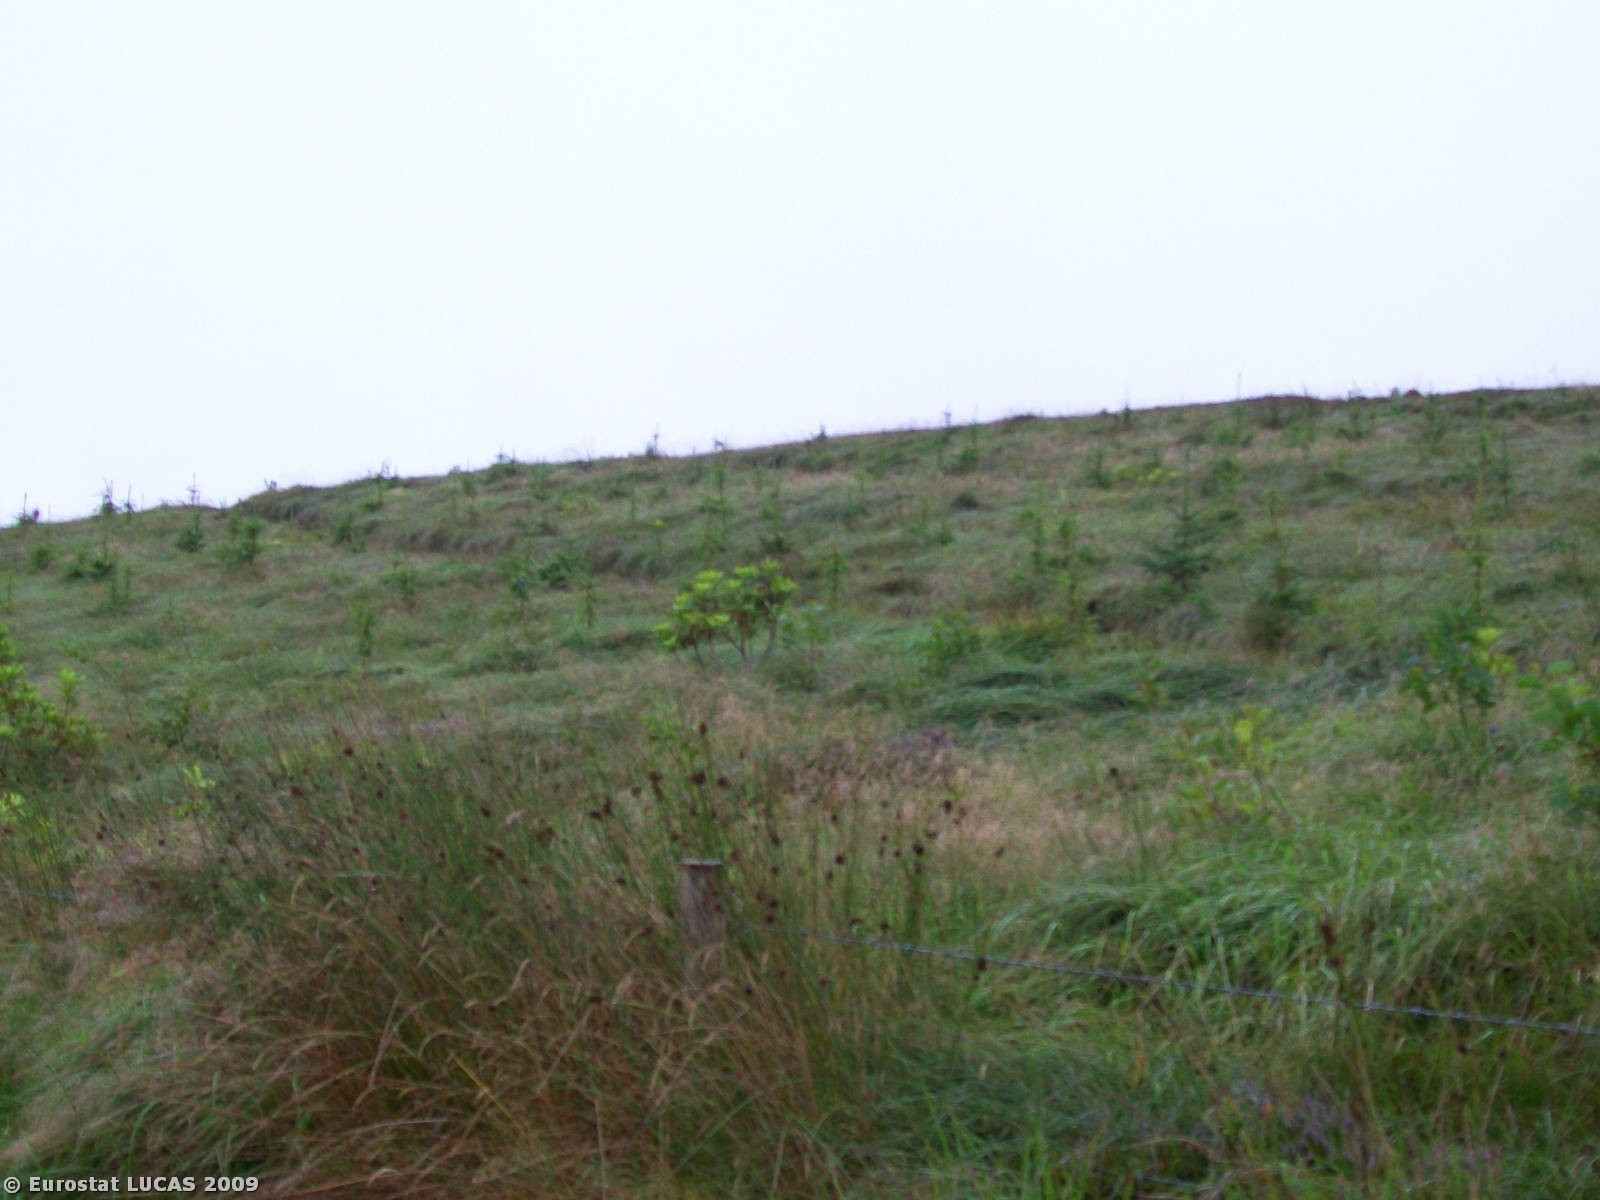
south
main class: Grassland
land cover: Grassland with sparse tree/shrub cover
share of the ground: > 75 %
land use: Agriculture (excluding fallow land and kitchen gardens)
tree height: < 5 m
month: August
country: IE
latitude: 52.8322
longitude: -9.2672
